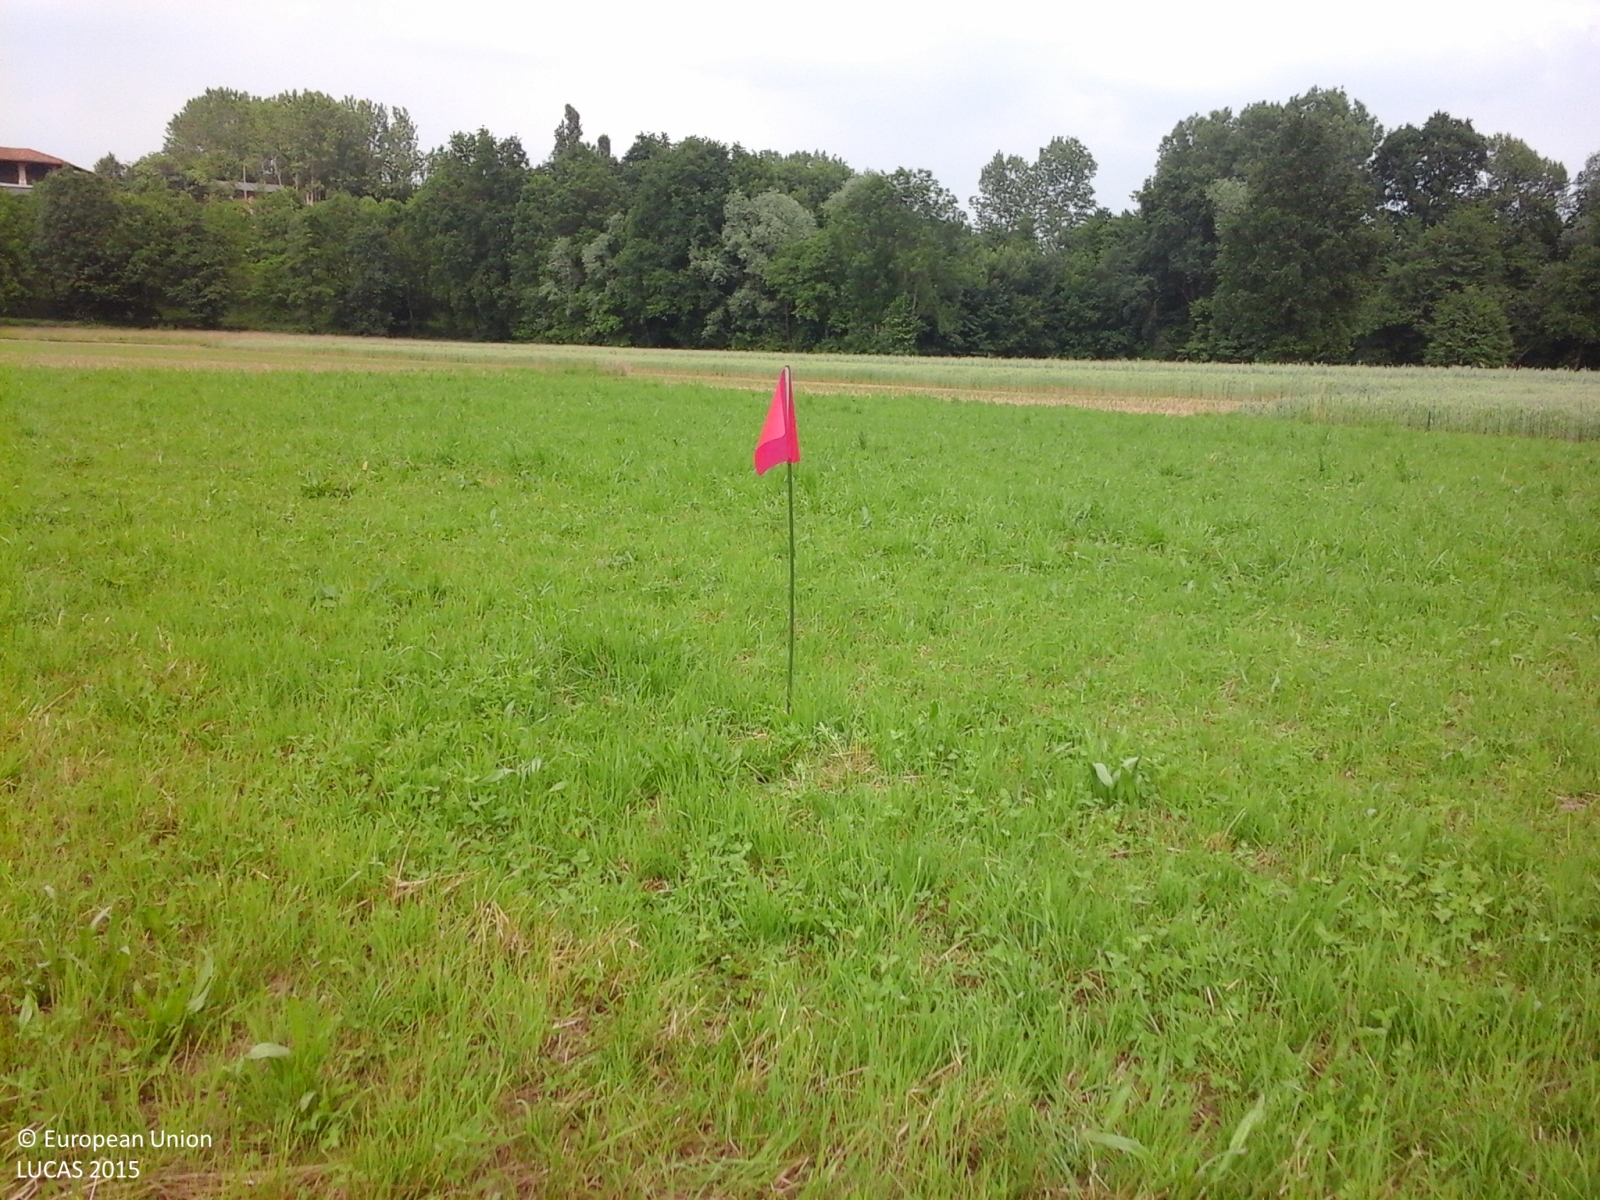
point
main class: Grassland
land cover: Grassland without tree/shrub cover
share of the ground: > 75 %
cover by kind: herbaceous plants 100 %
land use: Agriculture (excluding fallow land and kitchen gardens)
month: May
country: IT
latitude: 45.3721
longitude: 7.7436
